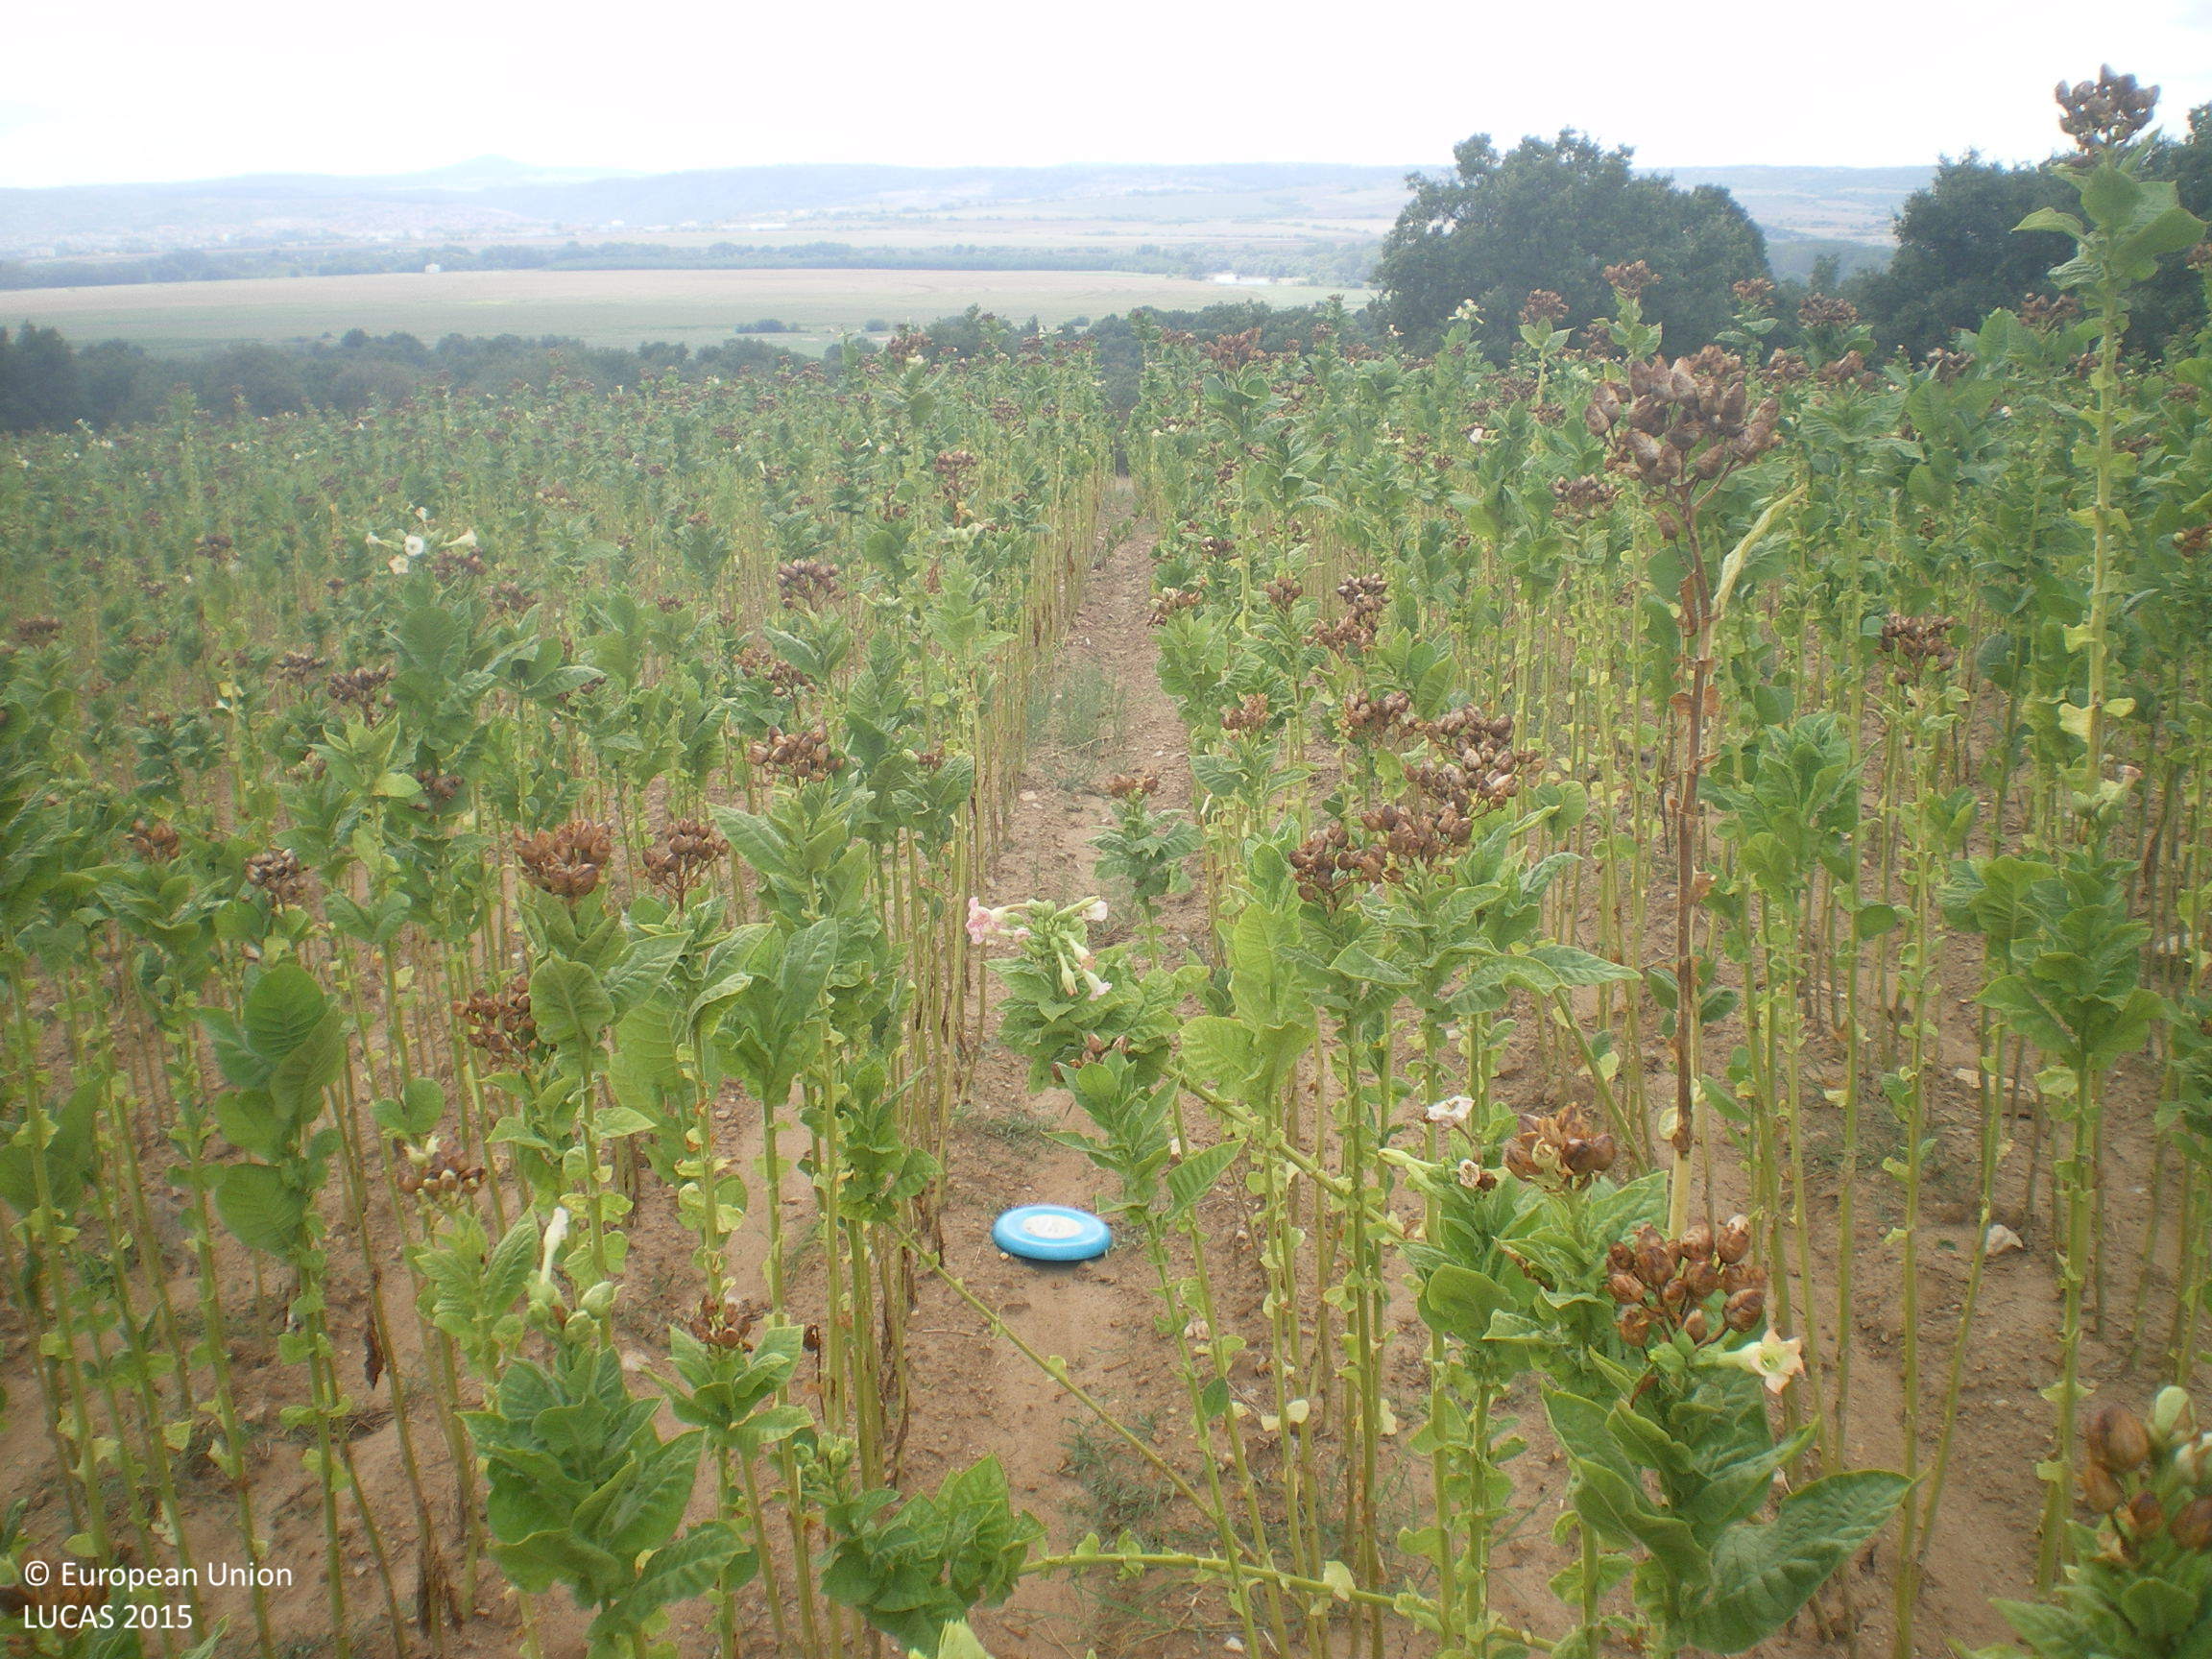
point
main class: Cropland
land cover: Tobacco
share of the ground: > 75 %
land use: Agriculture (excluding fallow land and kitchen gardens)
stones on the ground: > 50 %
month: September
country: BG
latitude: 41.9738
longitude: 25.9174
